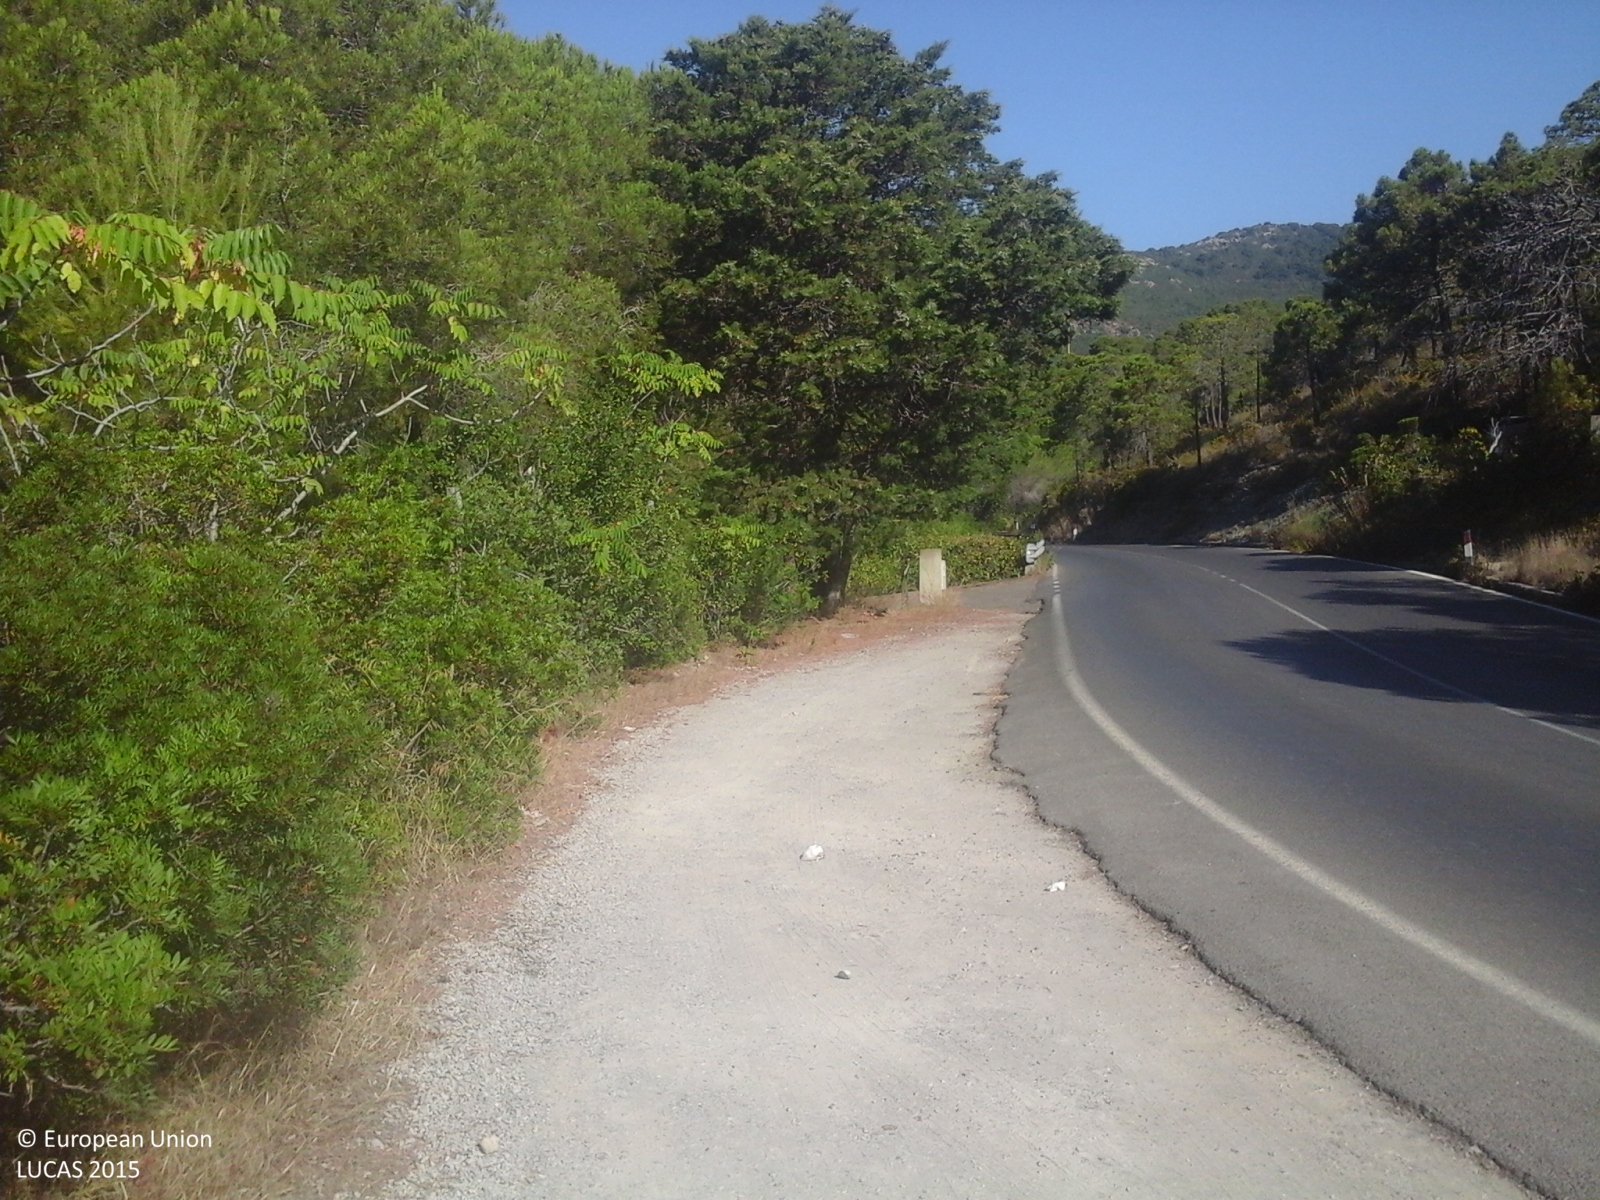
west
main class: Woodland
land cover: Pine dominated mixed woodland
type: coniferous forest of the mediterranean region
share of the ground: > 75 %
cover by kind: broadleaved forest trees 75 %, coniferous forest trees 25 %
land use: Semi-natural and natural areas not in use
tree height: > 5 m
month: July
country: IT
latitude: 42.7618
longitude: 10.3288
